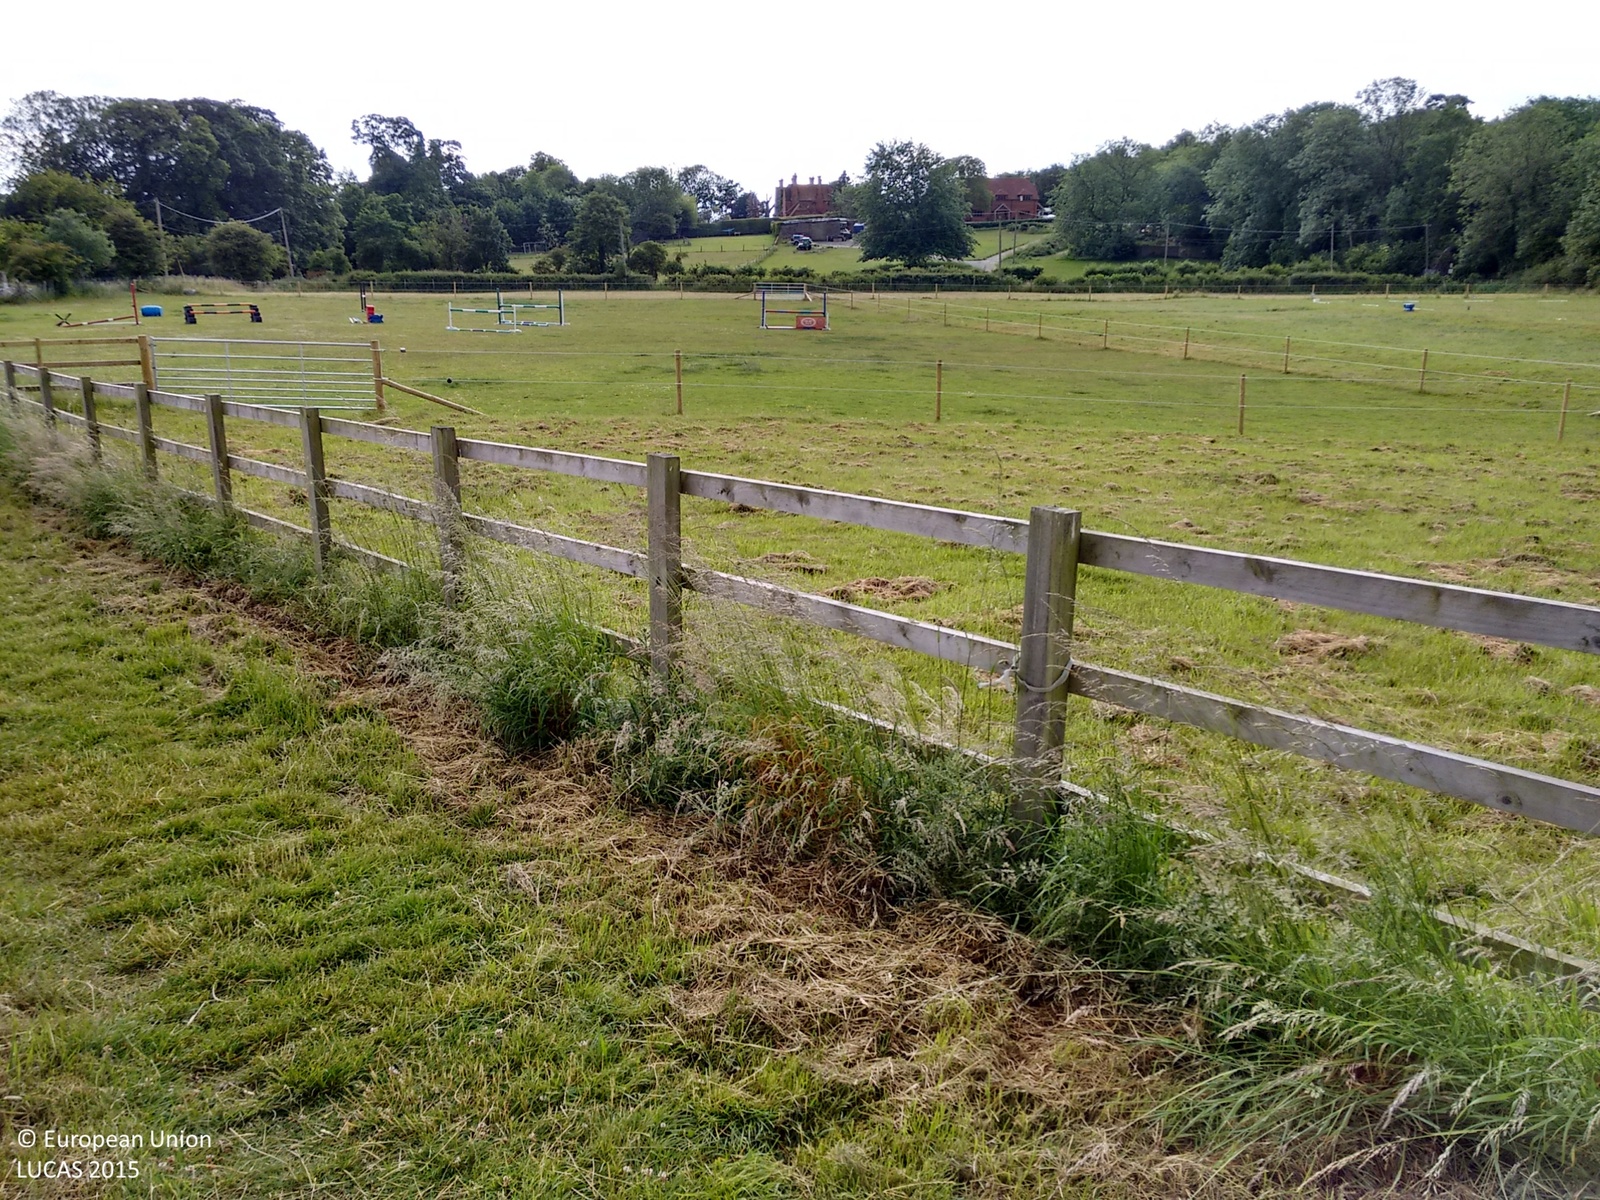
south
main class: Grassland
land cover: Grassland without tree/shrub cover
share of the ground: > 75 %
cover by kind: herbaceous plants 100 %
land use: Agriculture (excluding fallow land and kitchen gardens)
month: June
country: GB
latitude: 51.5145
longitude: -1.2443
